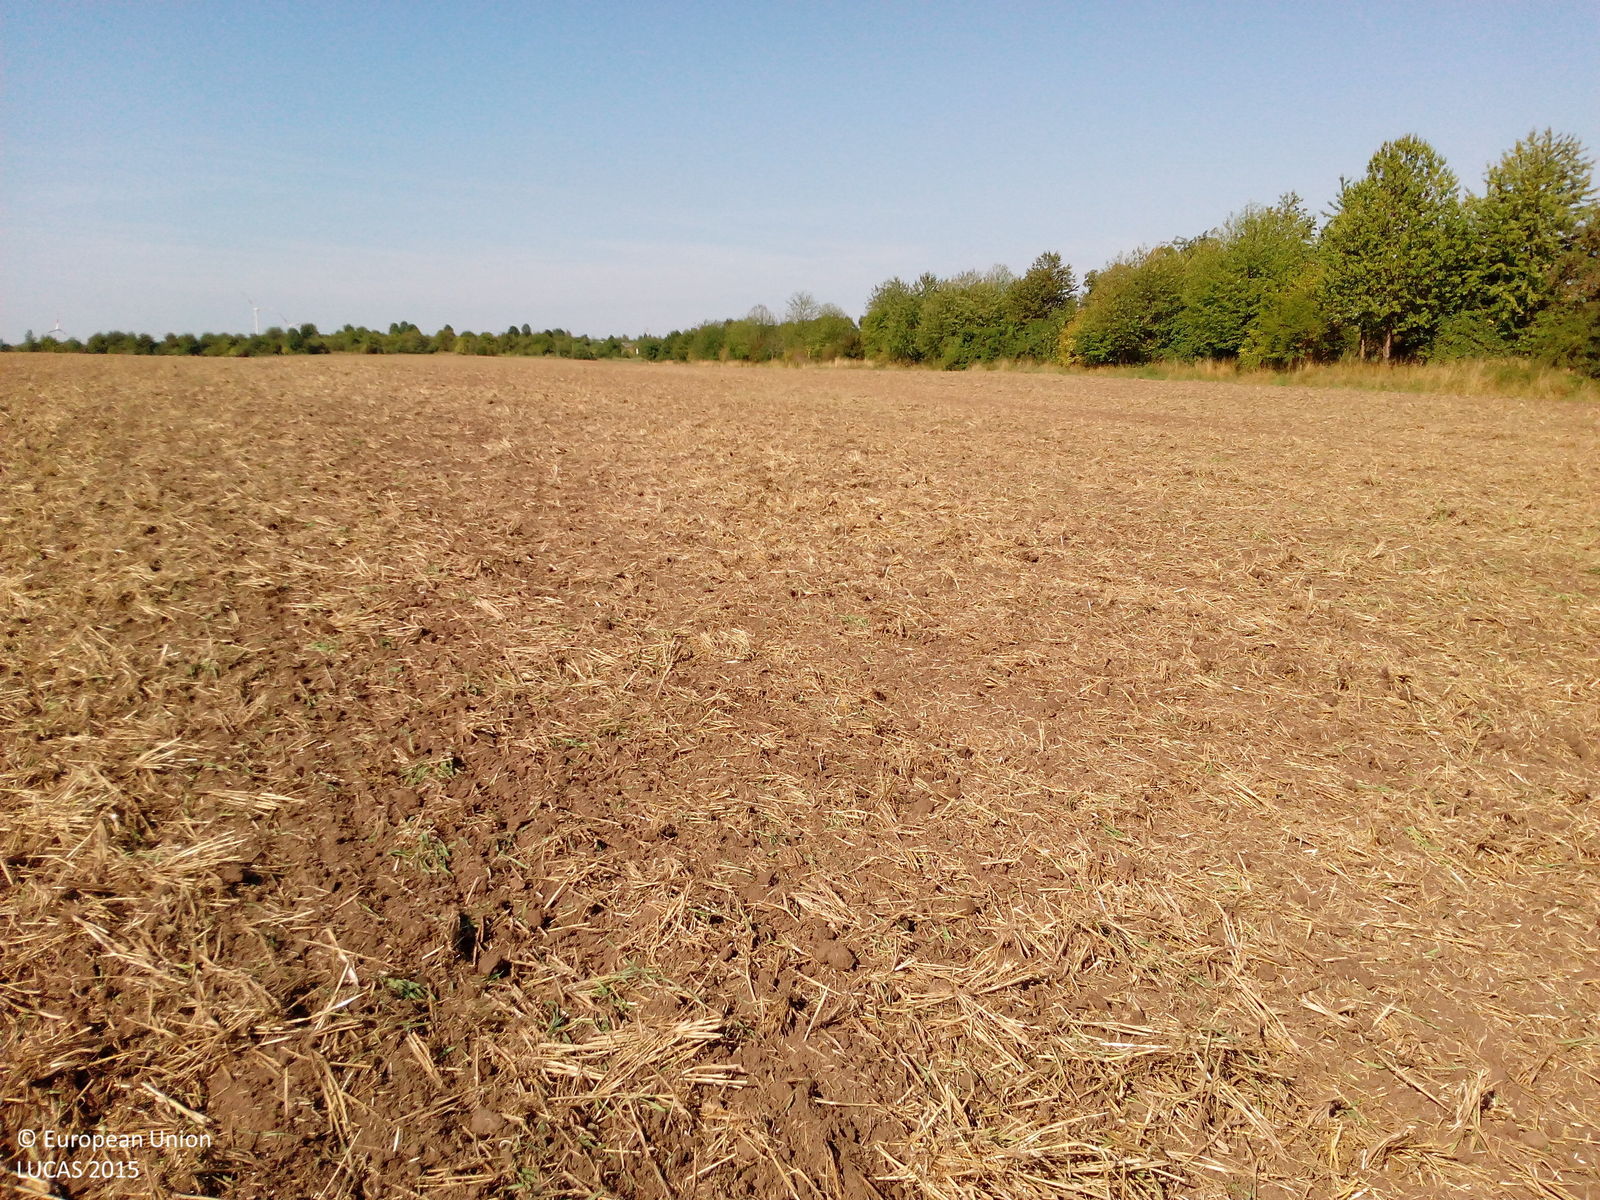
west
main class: Cropland
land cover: Barley
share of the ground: < 10 %
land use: Agriculture (excluding fallow land and kitchen gardens)
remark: Harvested field
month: August
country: DE
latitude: 50.9534
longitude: 10.9535
